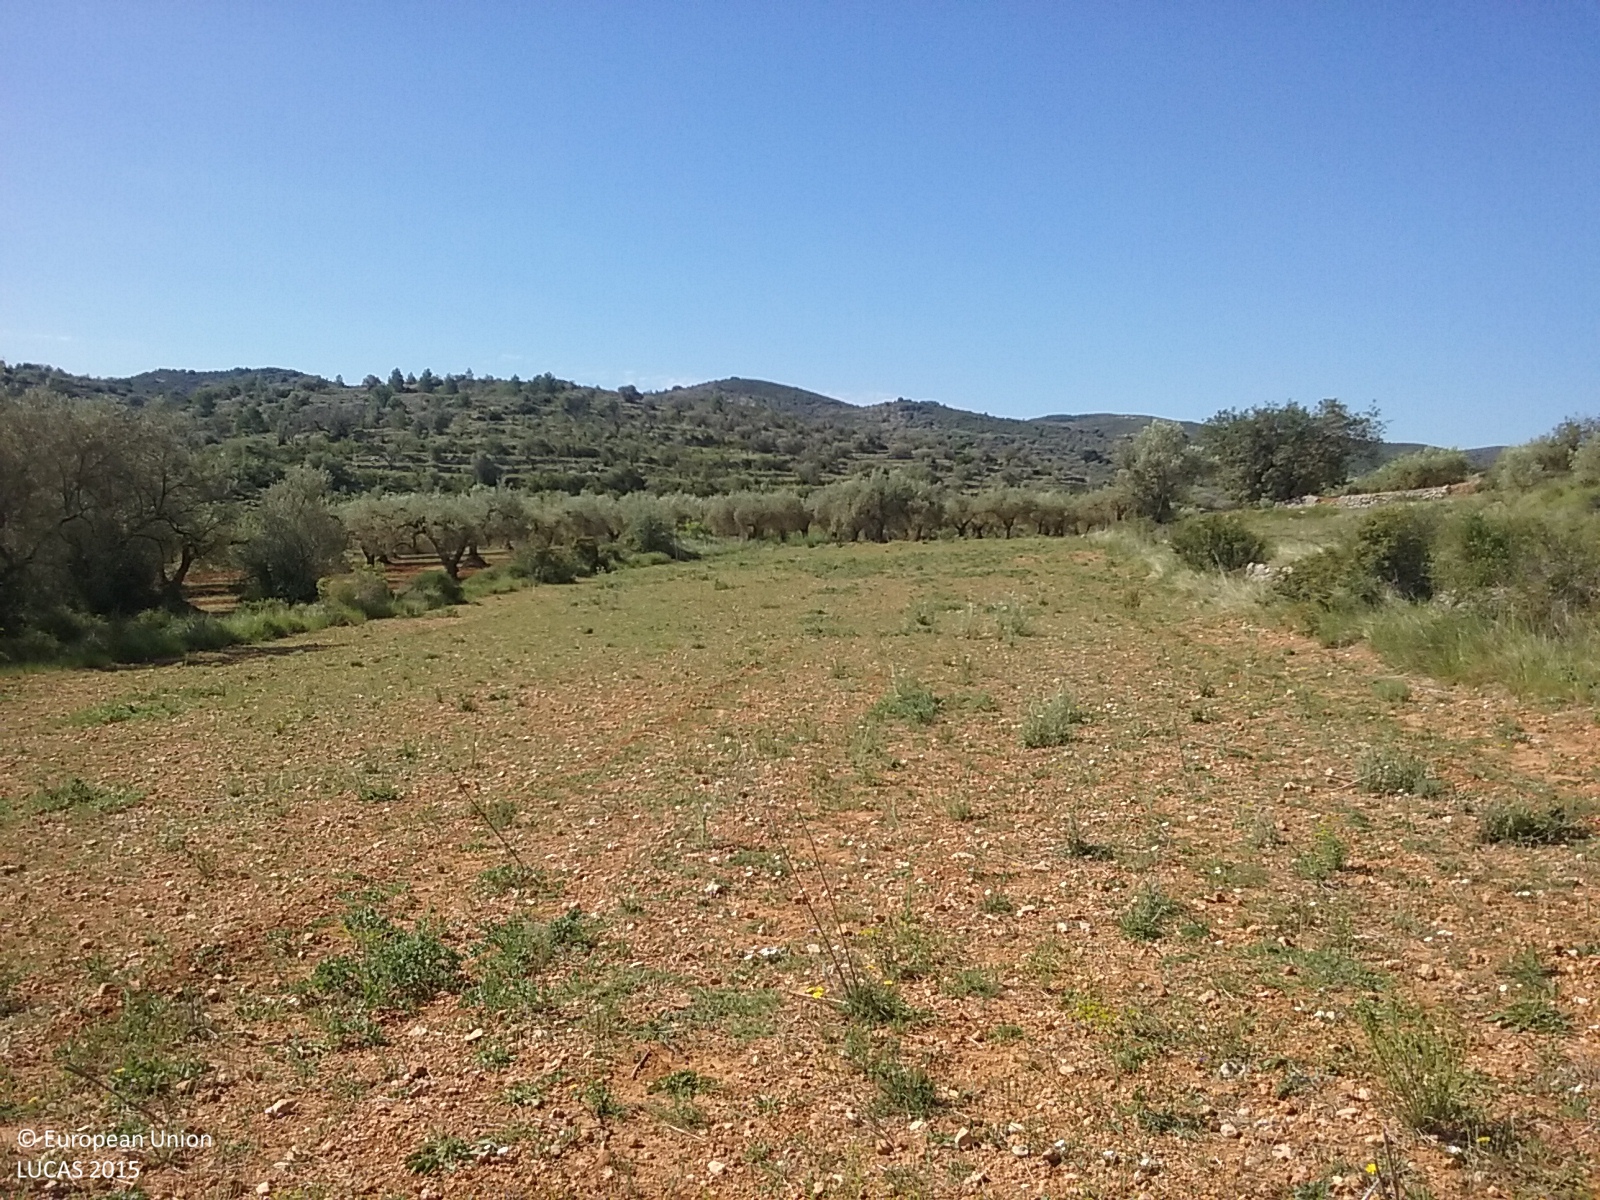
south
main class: Grassland
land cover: Spontaneously vegetated surfaces
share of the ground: 50 - 75 %
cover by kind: herbaceous plants 70 %, unconsolidated bare surface 30 %
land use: Fallow land
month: May
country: ES
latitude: 40.4382
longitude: 0.2702
